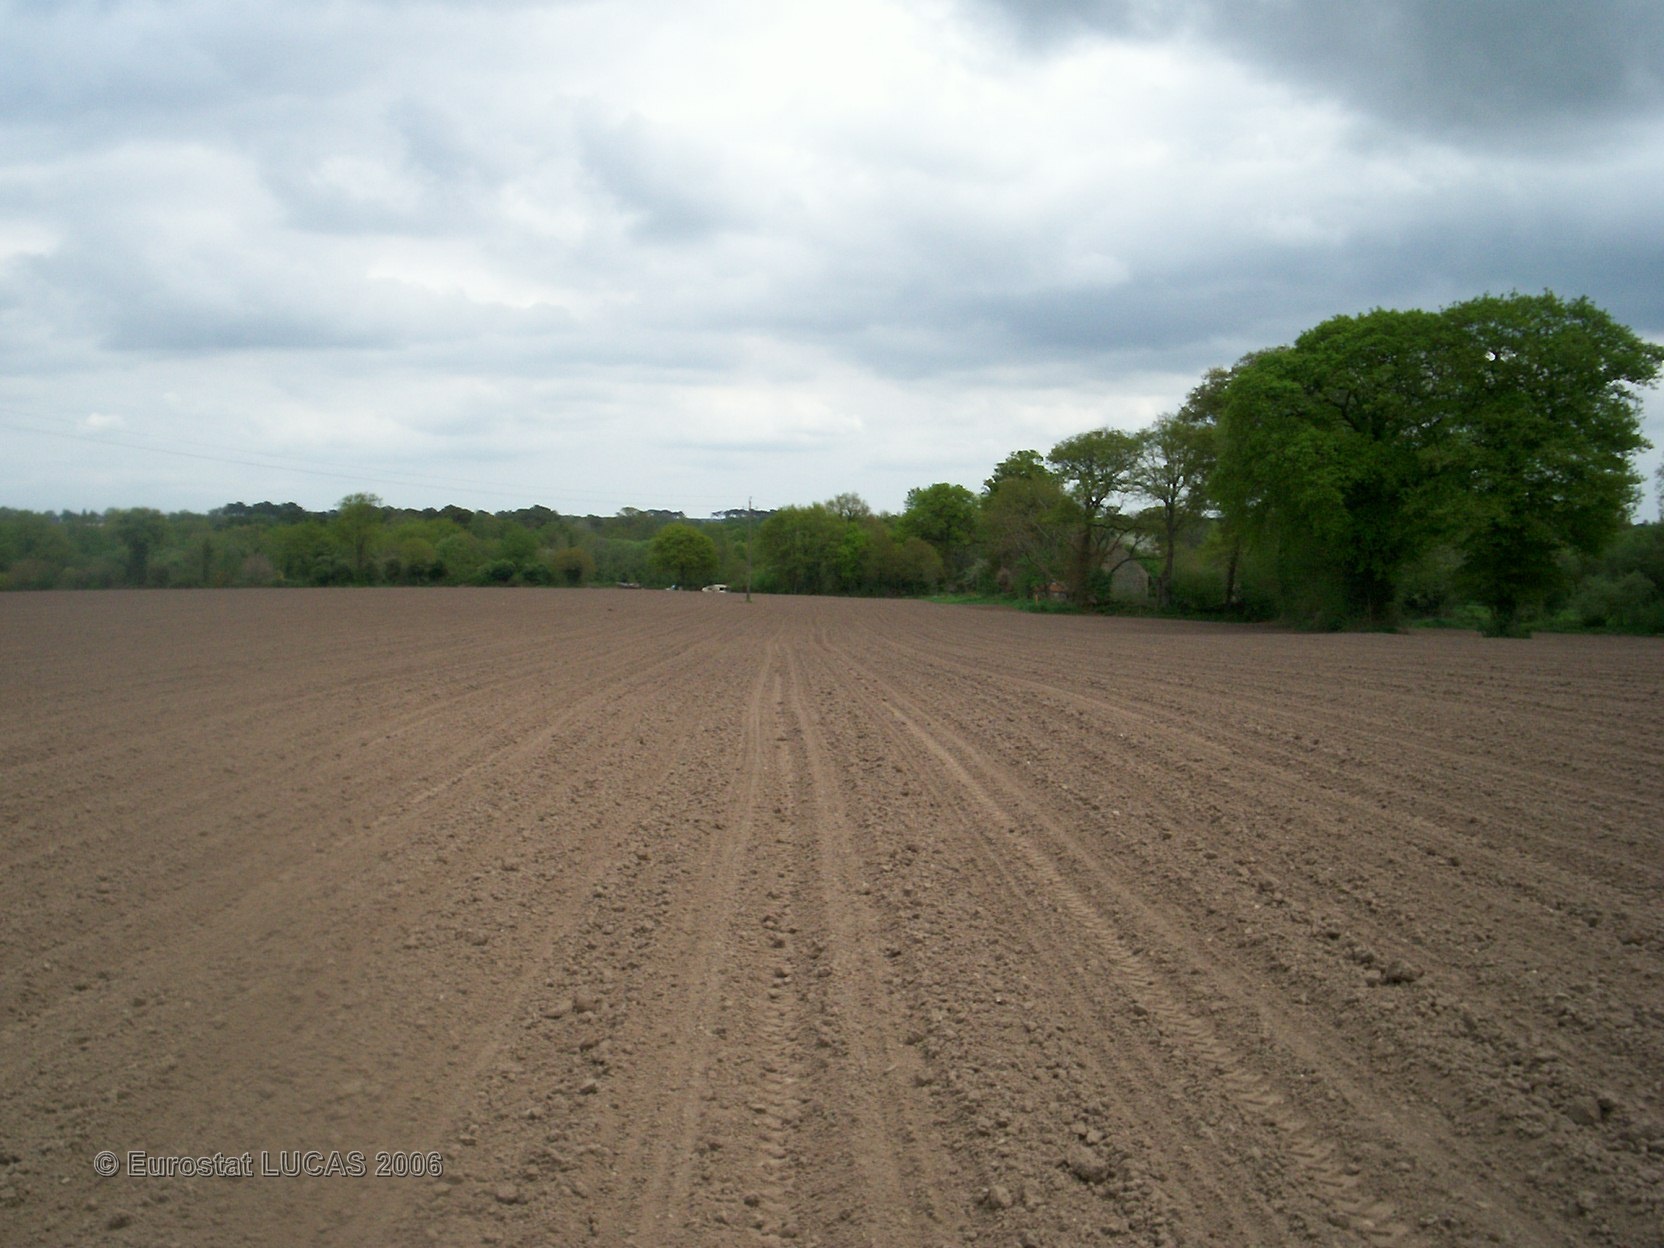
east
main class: Cropland
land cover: Maize
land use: Agriculture (excluding fallow land and kitchen gardens)
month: May
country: FR
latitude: 47.7230
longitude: -2.8487
